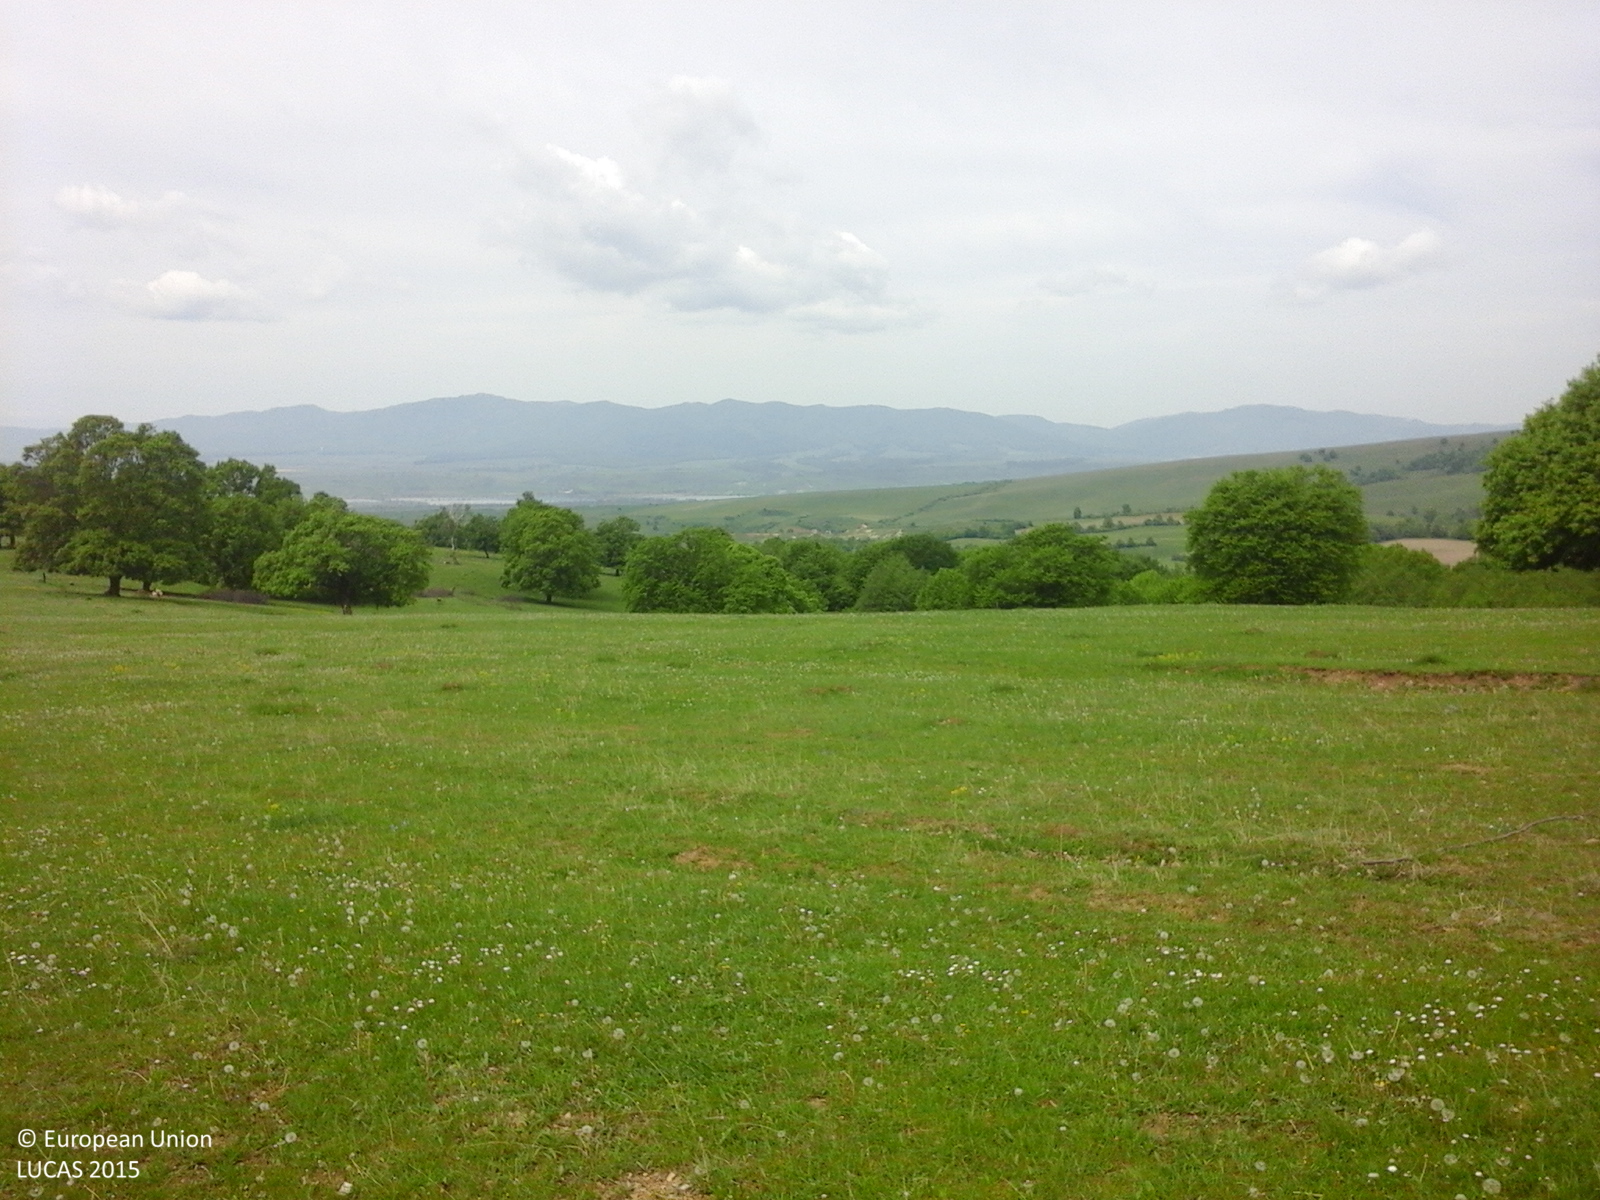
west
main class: Grassland
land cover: Grassland without tree/shrub cover
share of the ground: > 75 %
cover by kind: herbaceous plants 100 %
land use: Agriculture (excluding fallow land and kitchen gardens)
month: May
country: RO
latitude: 45.8715
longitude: 25.6306
